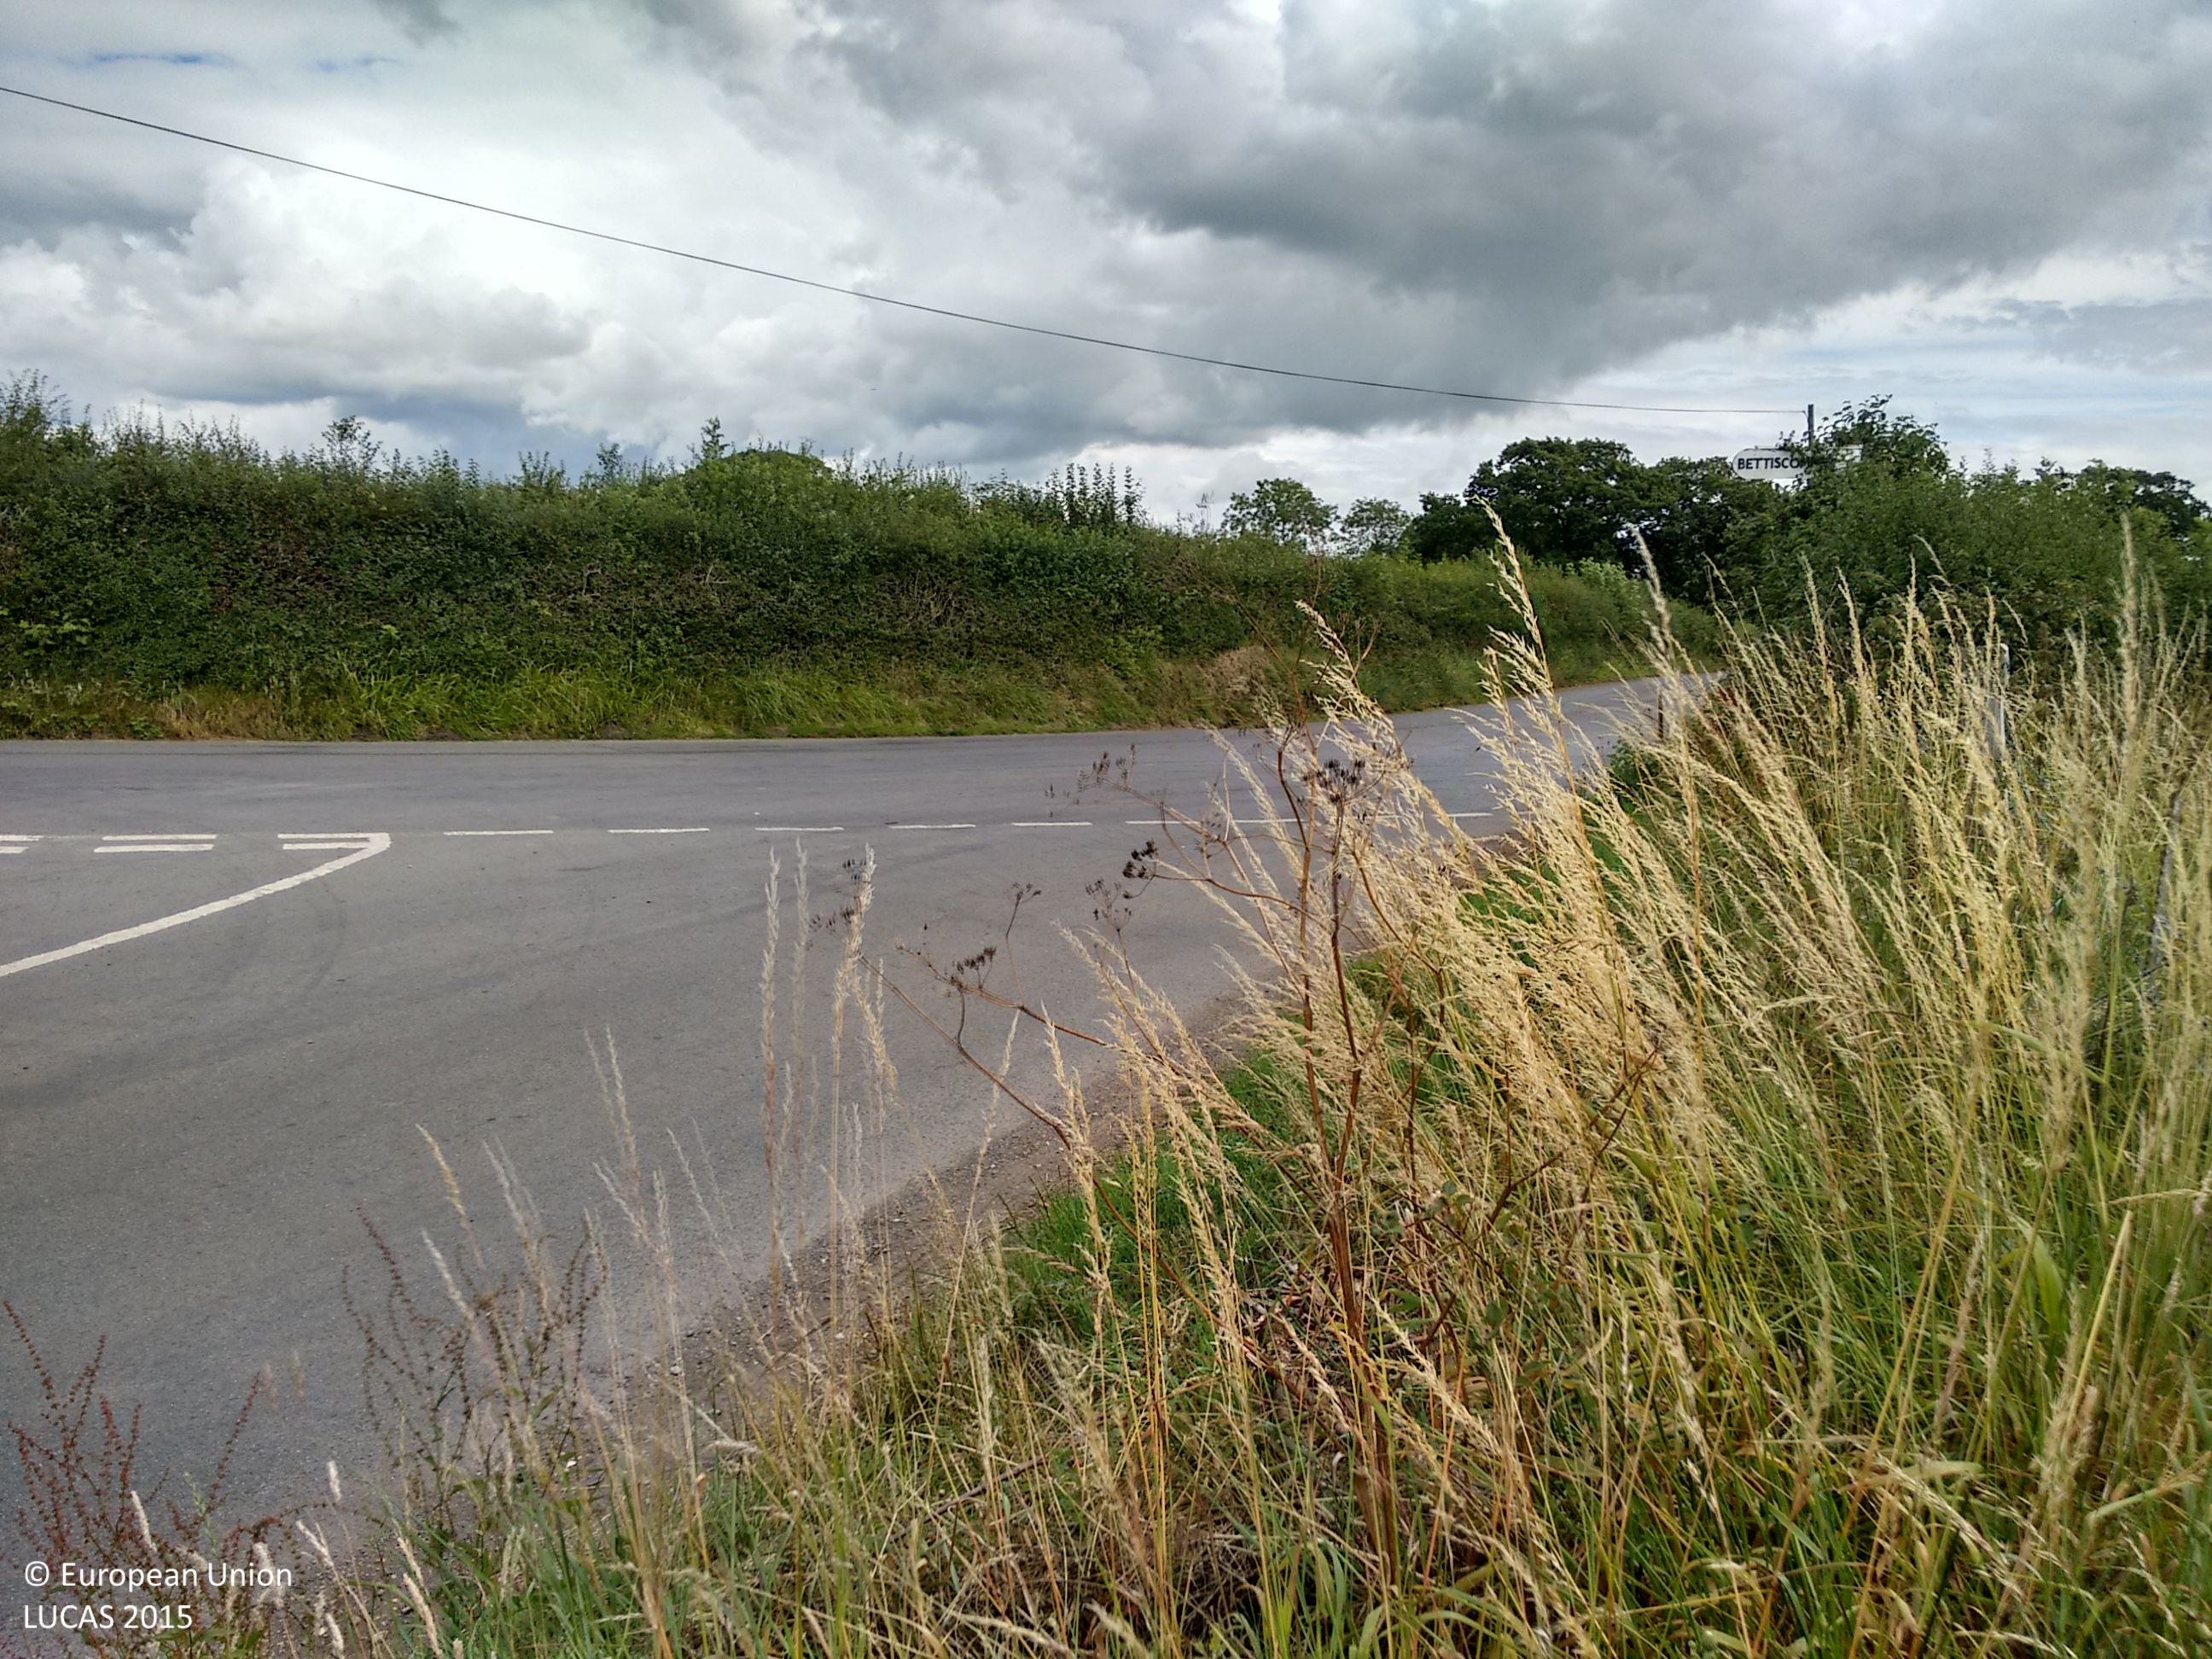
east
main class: Cropland
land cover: Maize
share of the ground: > 75 %
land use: Agriculture (excluding fallow land and kitchen gardens)
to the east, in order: Maize; Managed hedges; Ditches and canals; Grass margins; Paved roads, cycling and walking lanes; Grass margins; Ditches and canals; Managed hedges; Grassland without tree/shrub cover; Managed hedges
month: July
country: GB
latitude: 50.7828
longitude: -2.8513
